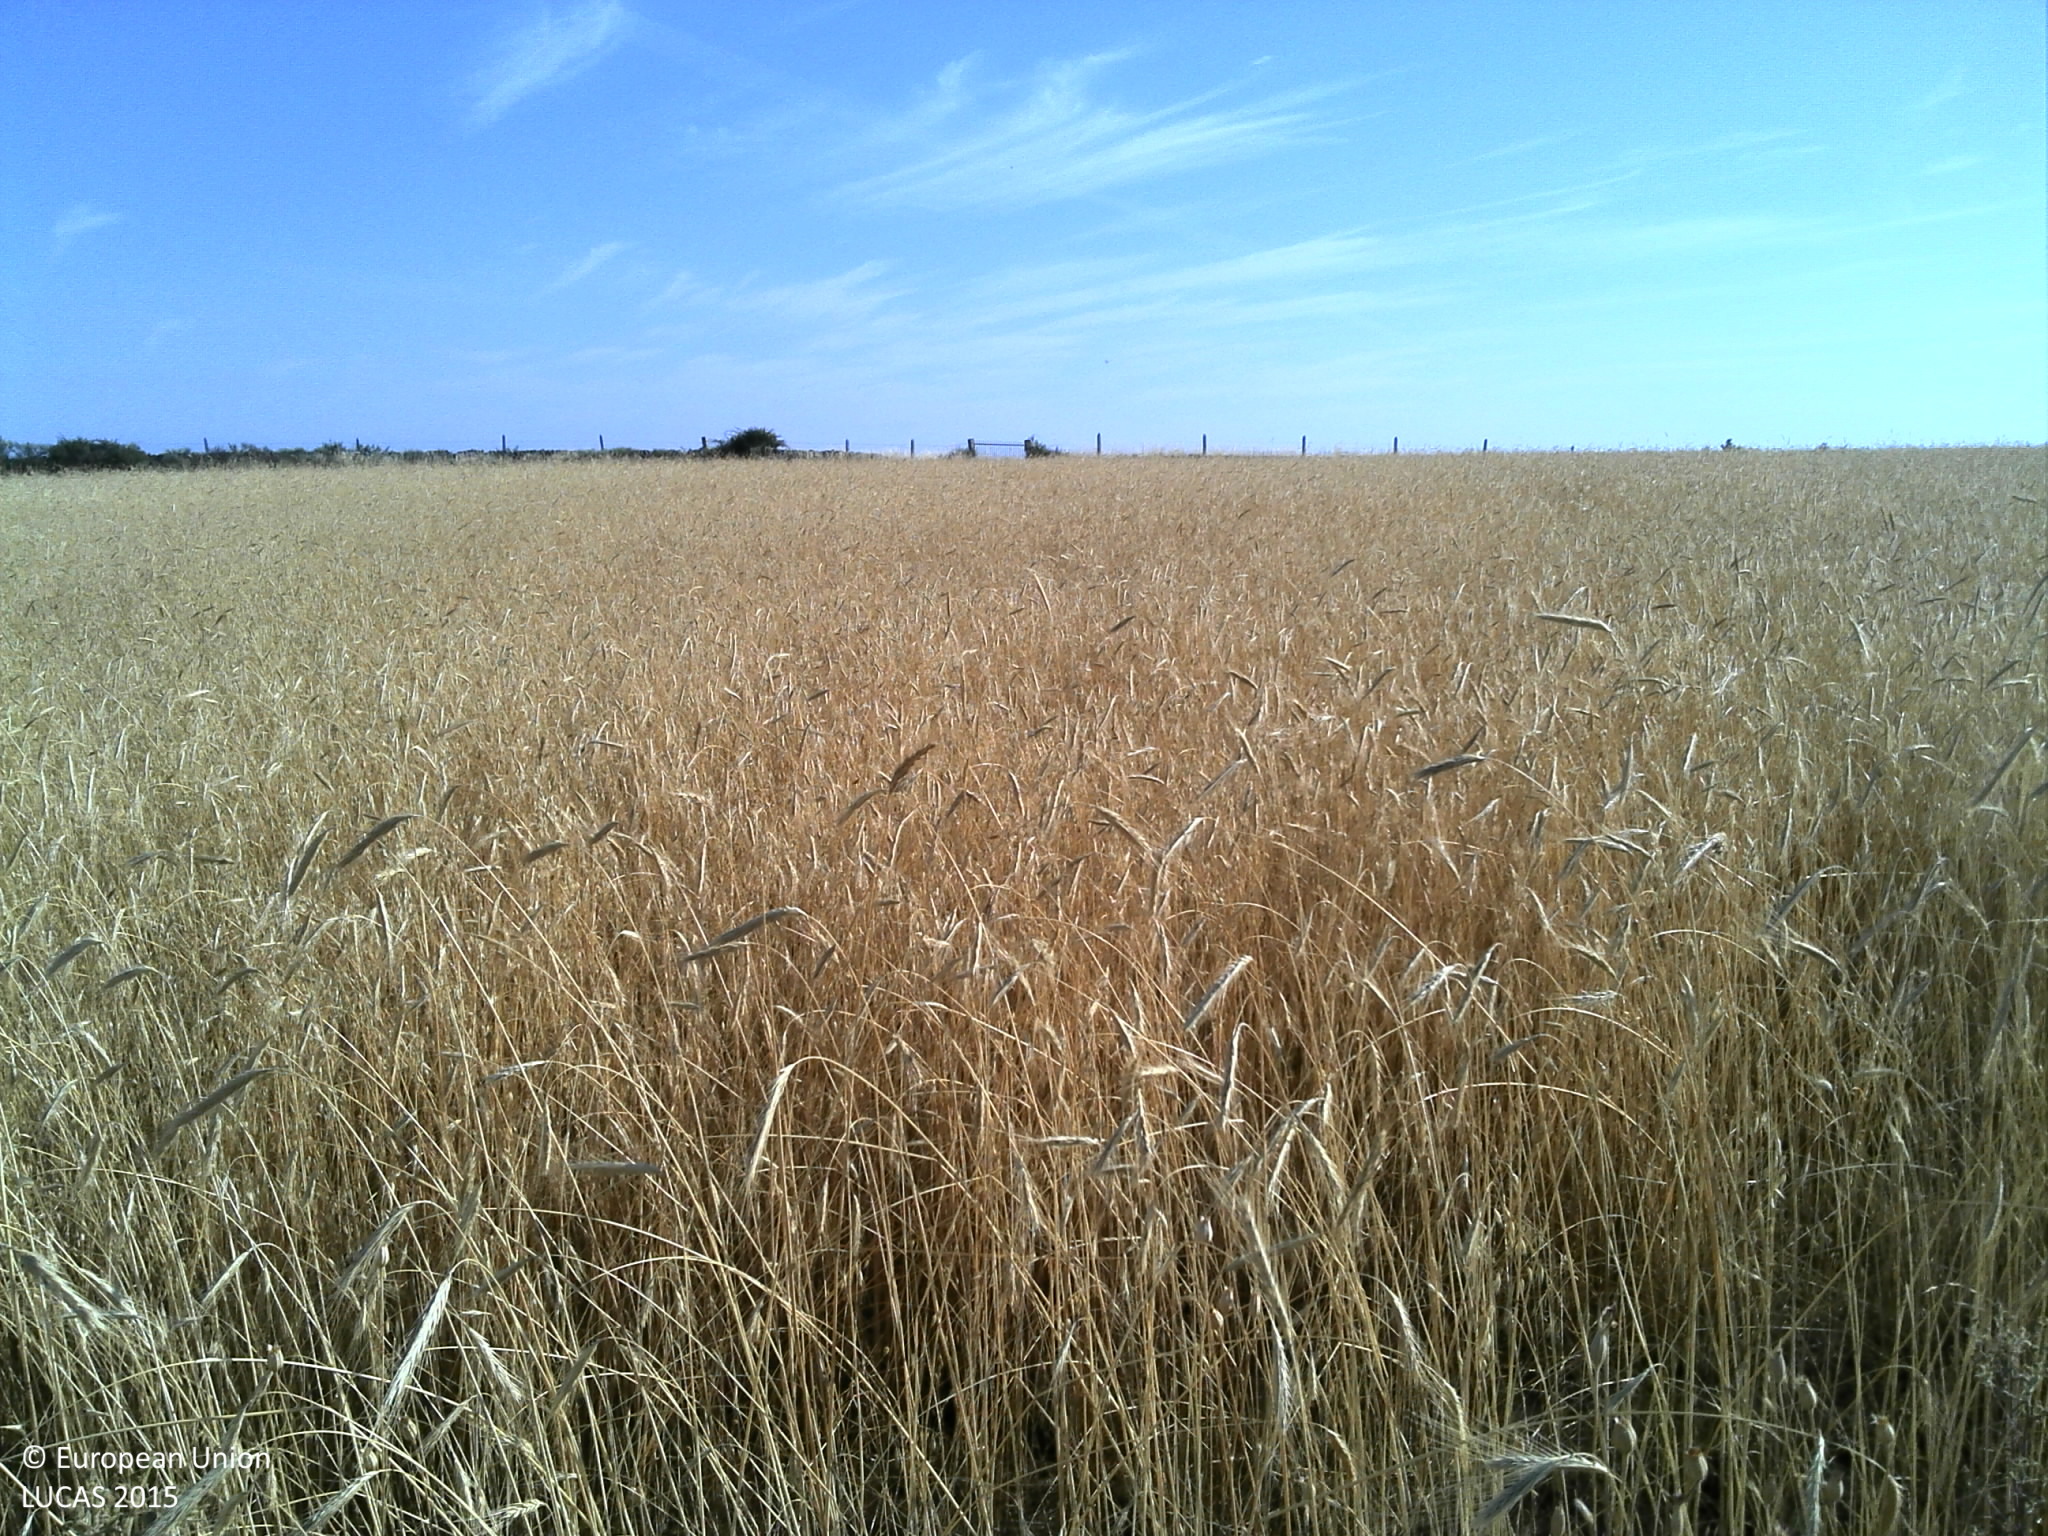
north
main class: Cropland
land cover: Barley
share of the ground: > 75 %
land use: Agriculture (excluding fallow land and kitchen gardens)
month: June
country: PT
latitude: 40.8907
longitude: -6.8972
